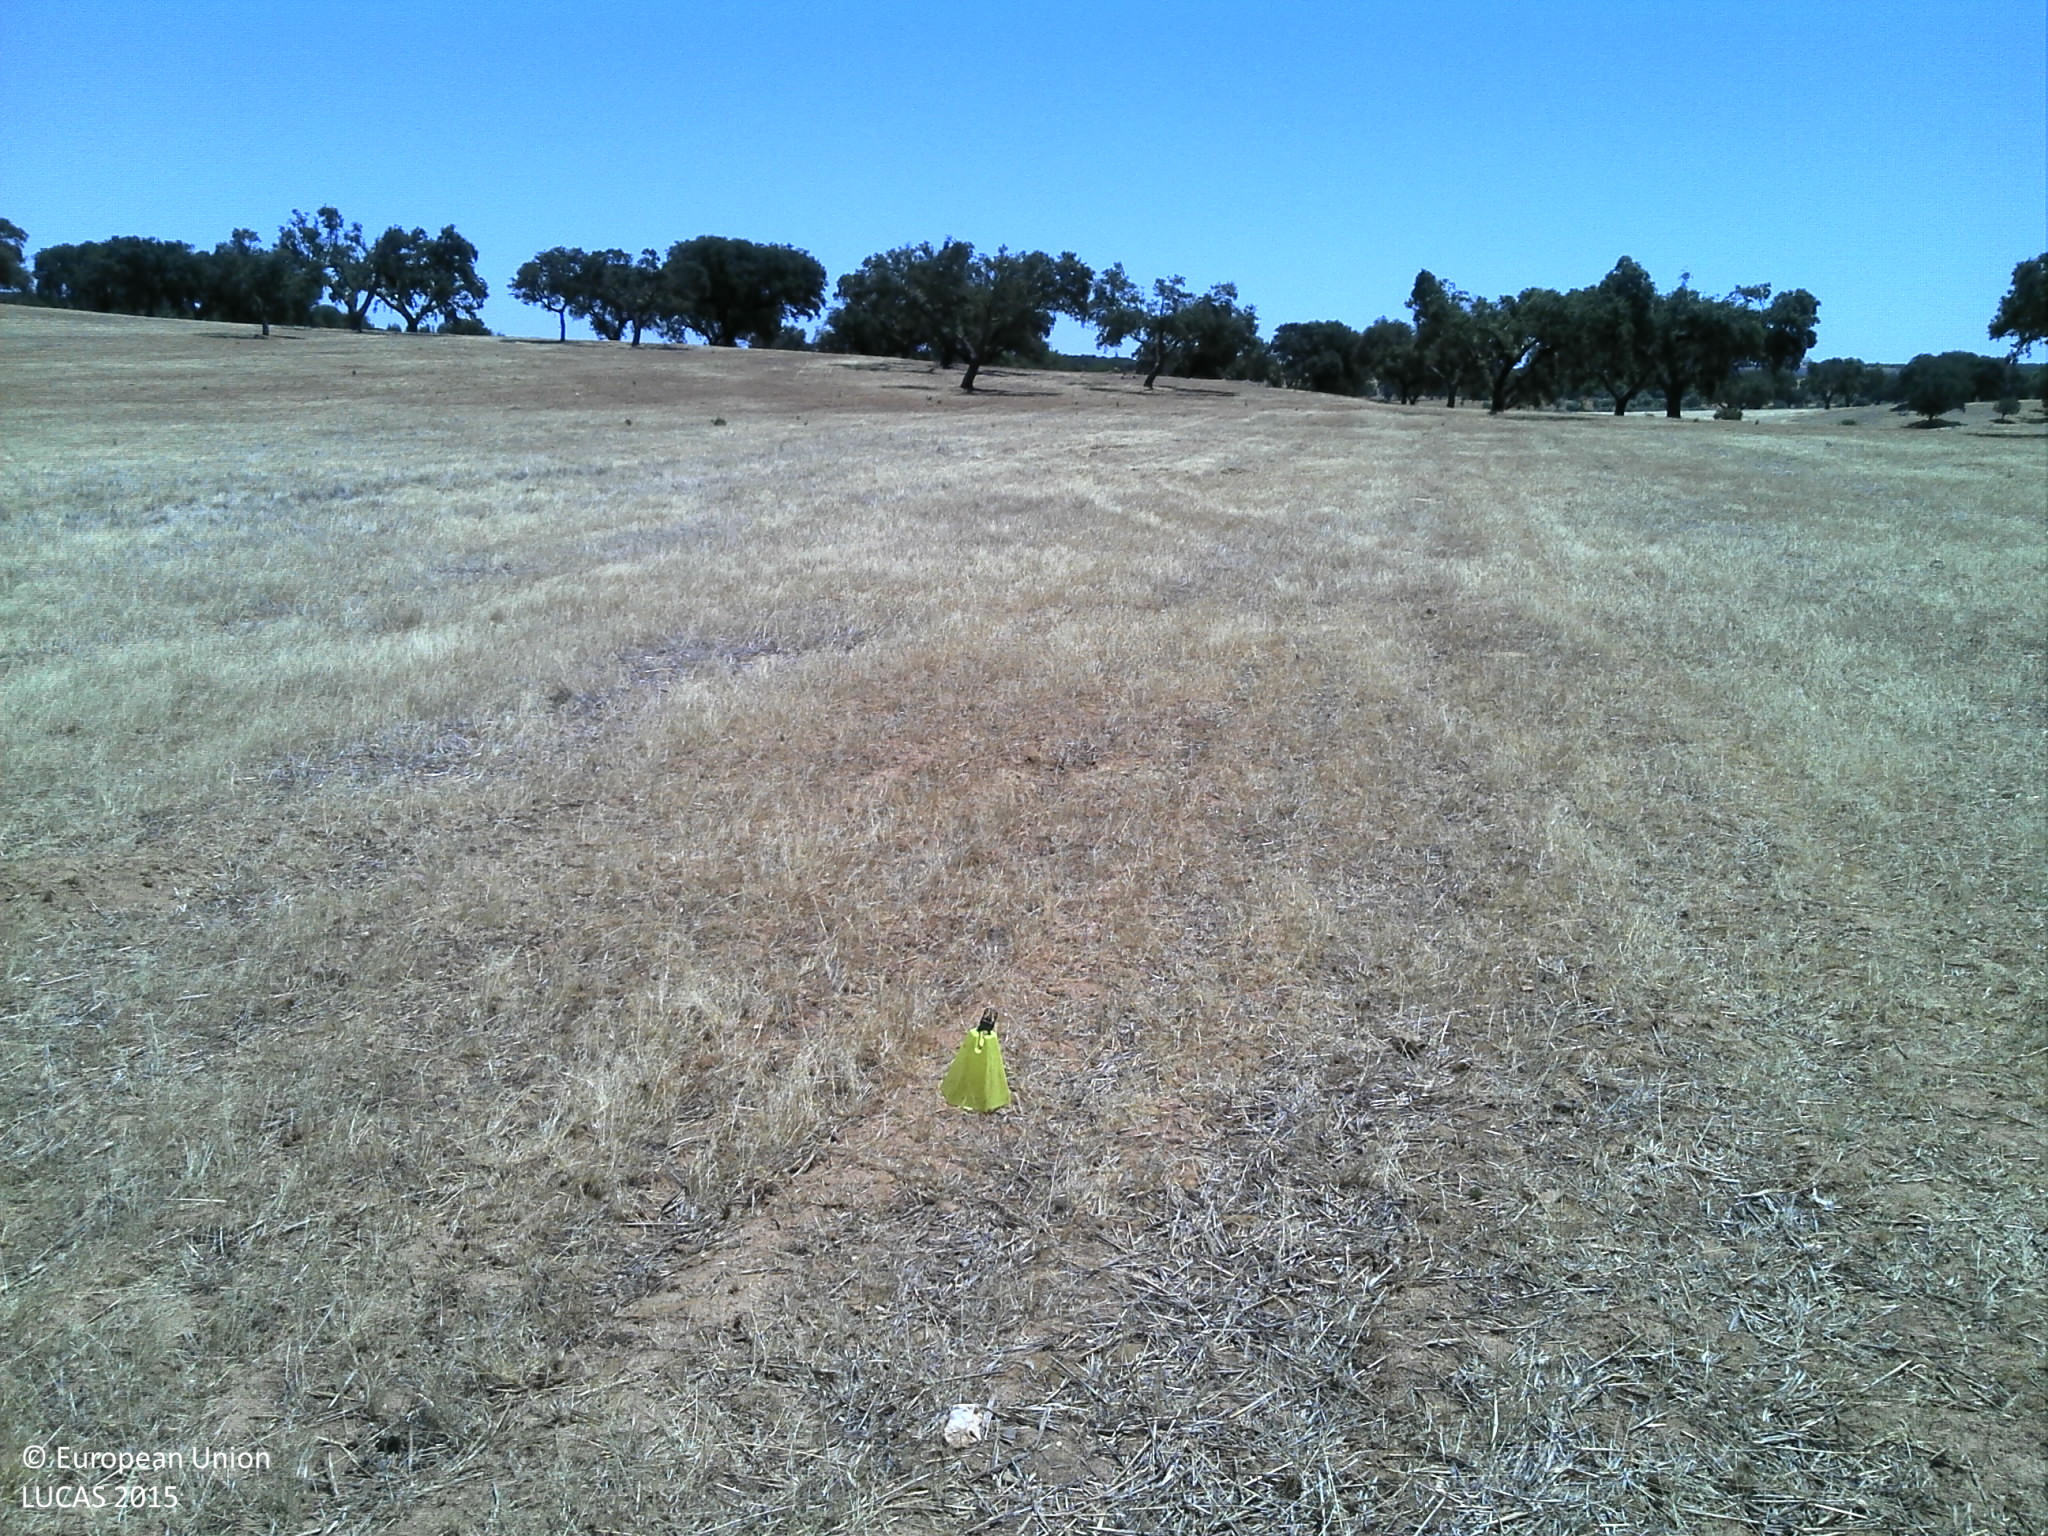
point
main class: Grassland
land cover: Grassland without tree/shrub cover
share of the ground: 10 - 25 %
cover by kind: unconsolidated bare surface 80 %, herbaceous plants 20 %
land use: Agriculture (excluding fallow land and kitchen gardens)
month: July
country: PT
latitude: 38.8836
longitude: -7.5003
